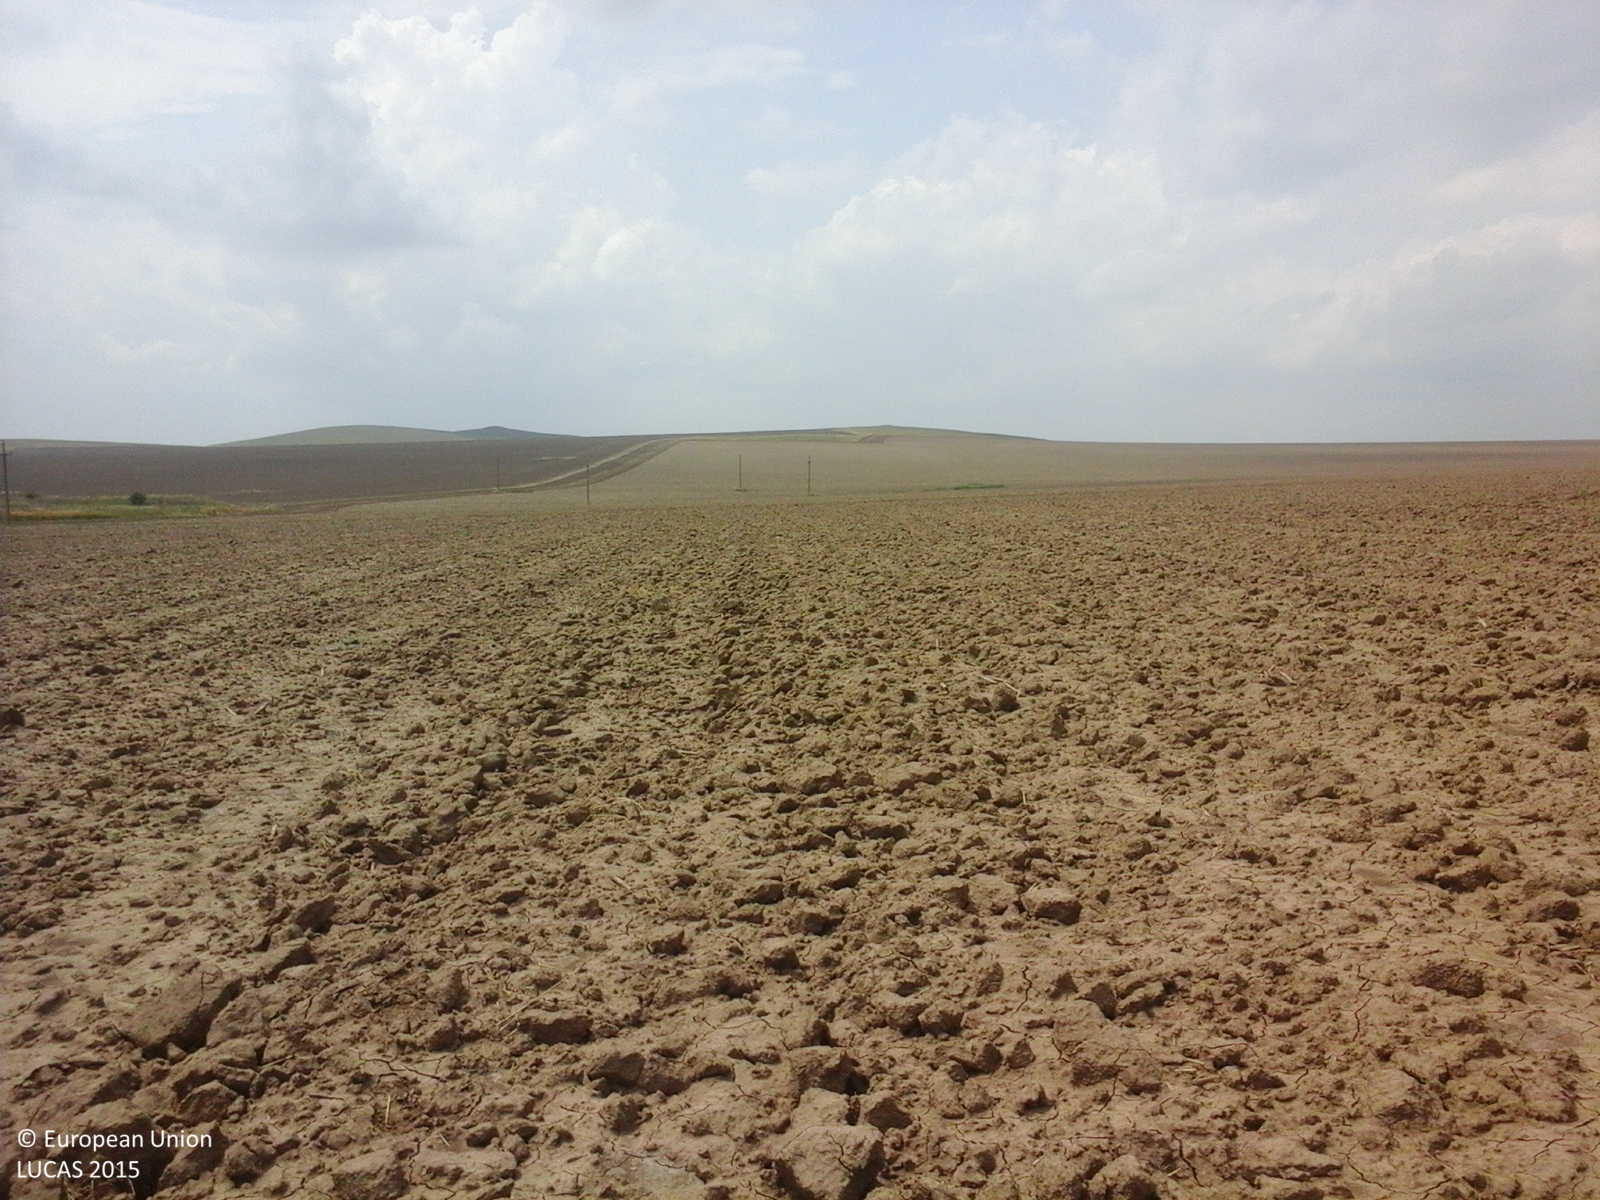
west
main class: Cropland
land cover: Common wheat
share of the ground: < 10 %
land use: Agriculture (excluding fallow land and kitchen gardens)
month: July
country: RO
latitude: 44.9798
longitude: 28.7929
